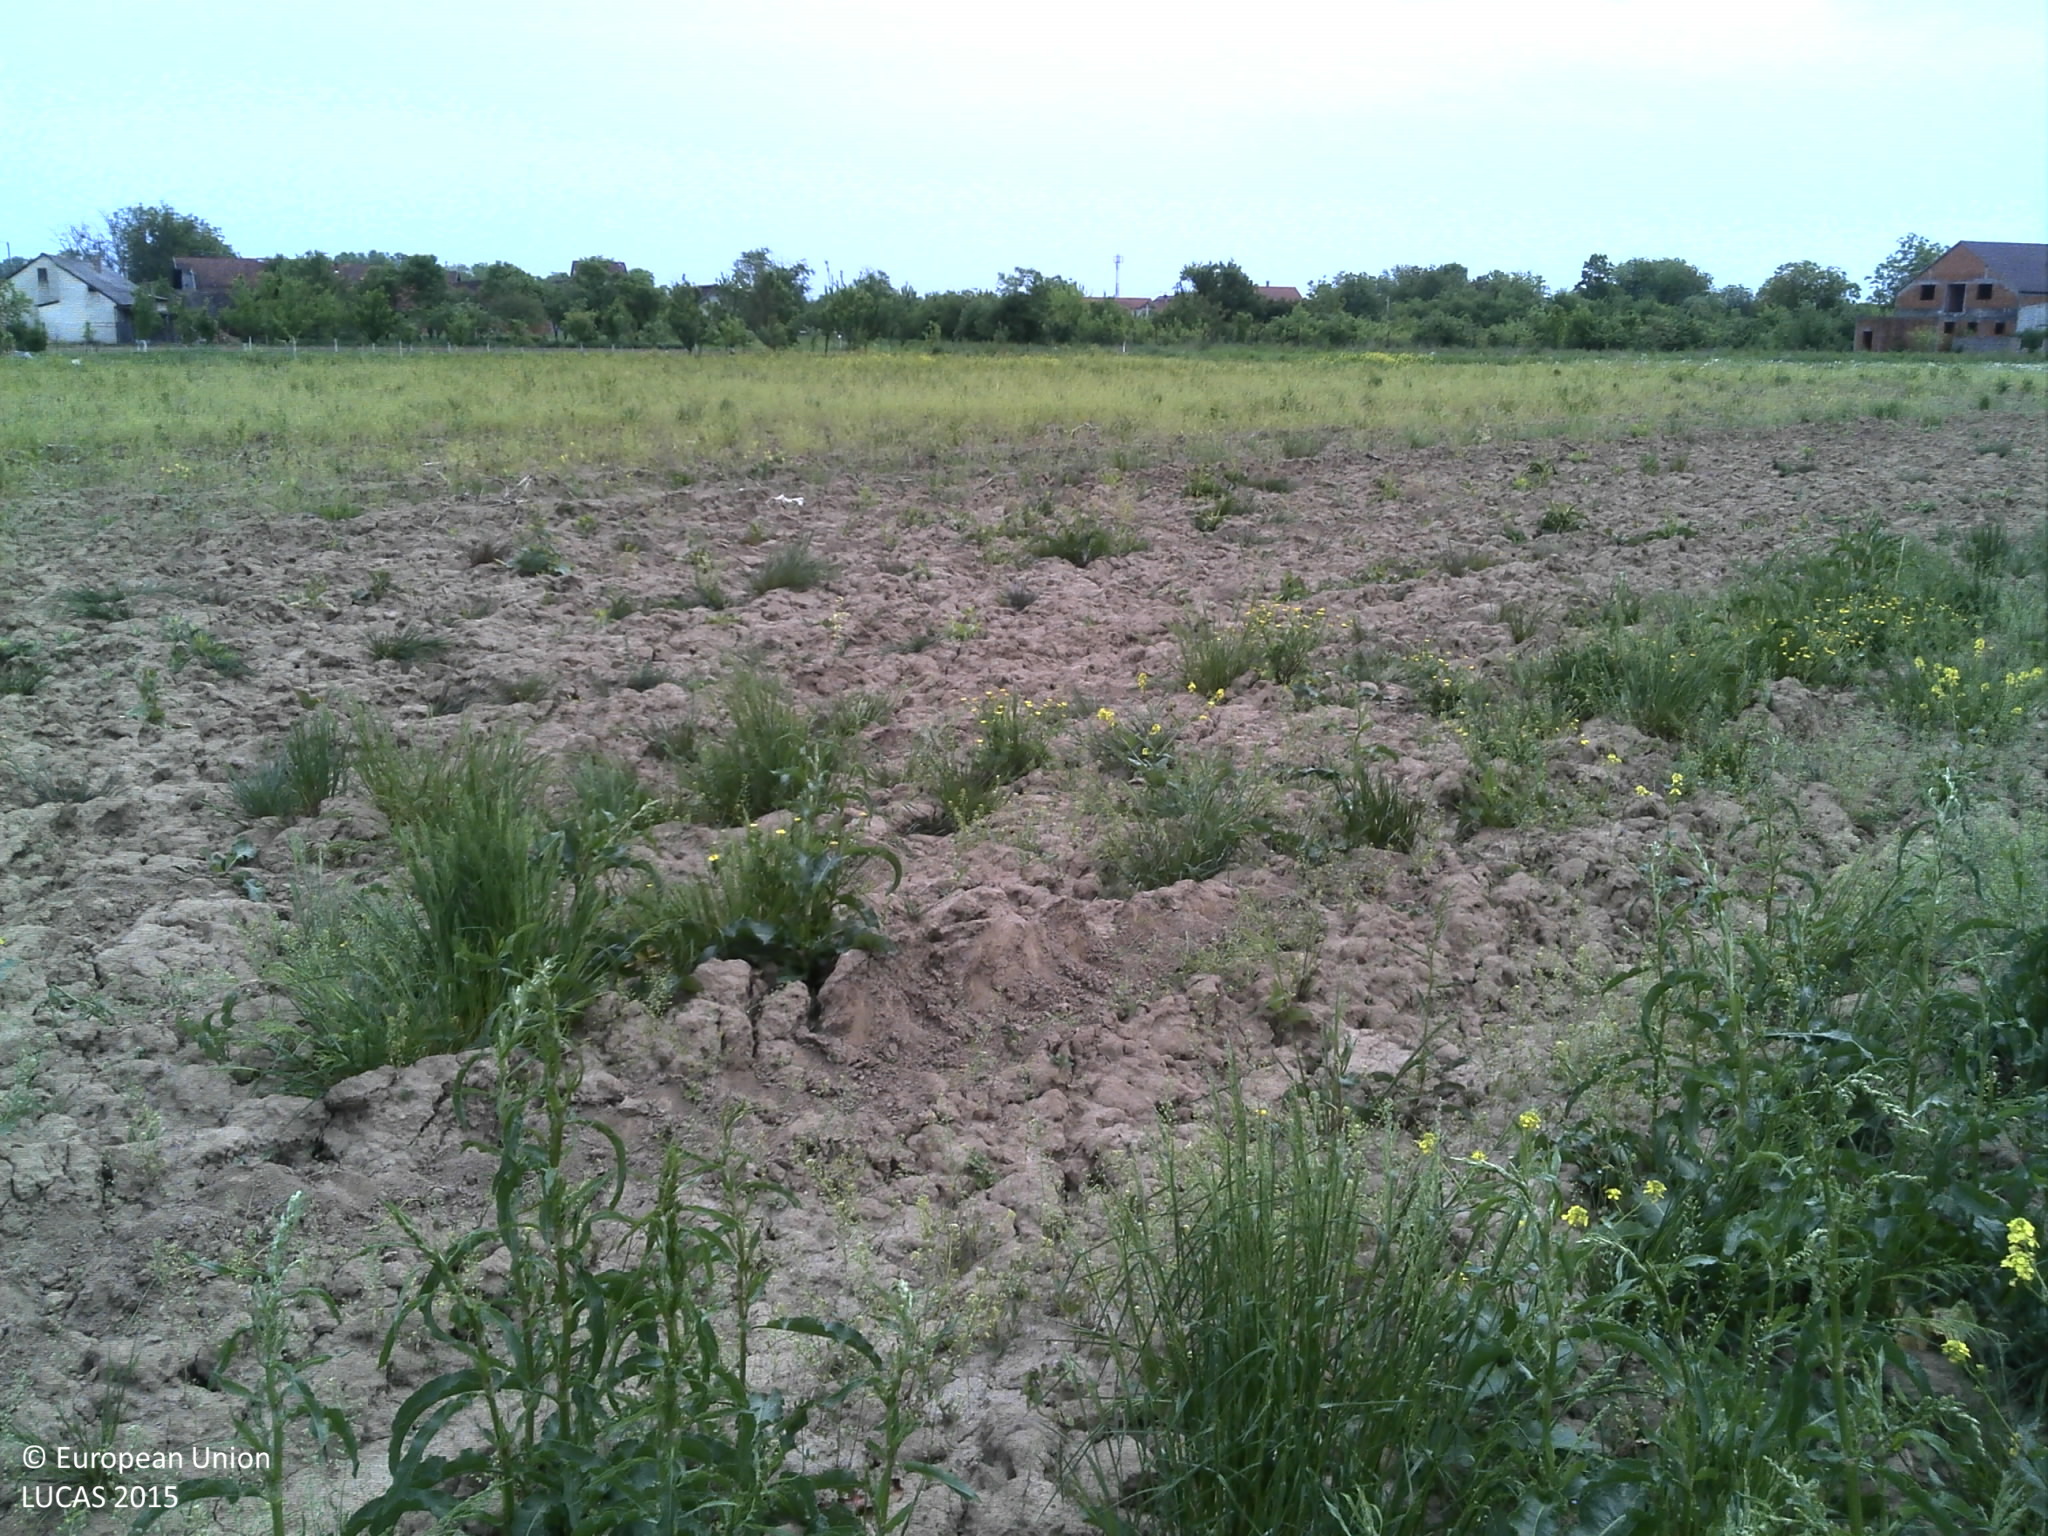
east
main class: Grassland
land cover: Spontaneously vegetated surfaces
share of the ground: > 75 %
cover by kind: herbaceous plants 100 %
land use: Fallow land
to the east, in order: Spontaneously vegetated surfaces; Apple fruit; Potatoes; Cherry fruit; Maize; Cherry fruit; Potatoes; Other root crops; Tomatoes; Other fruit trees and berries; Clovers; Artificial constructions in urban areas
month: May
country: HR
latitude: 45.0725
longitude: 18.4765
